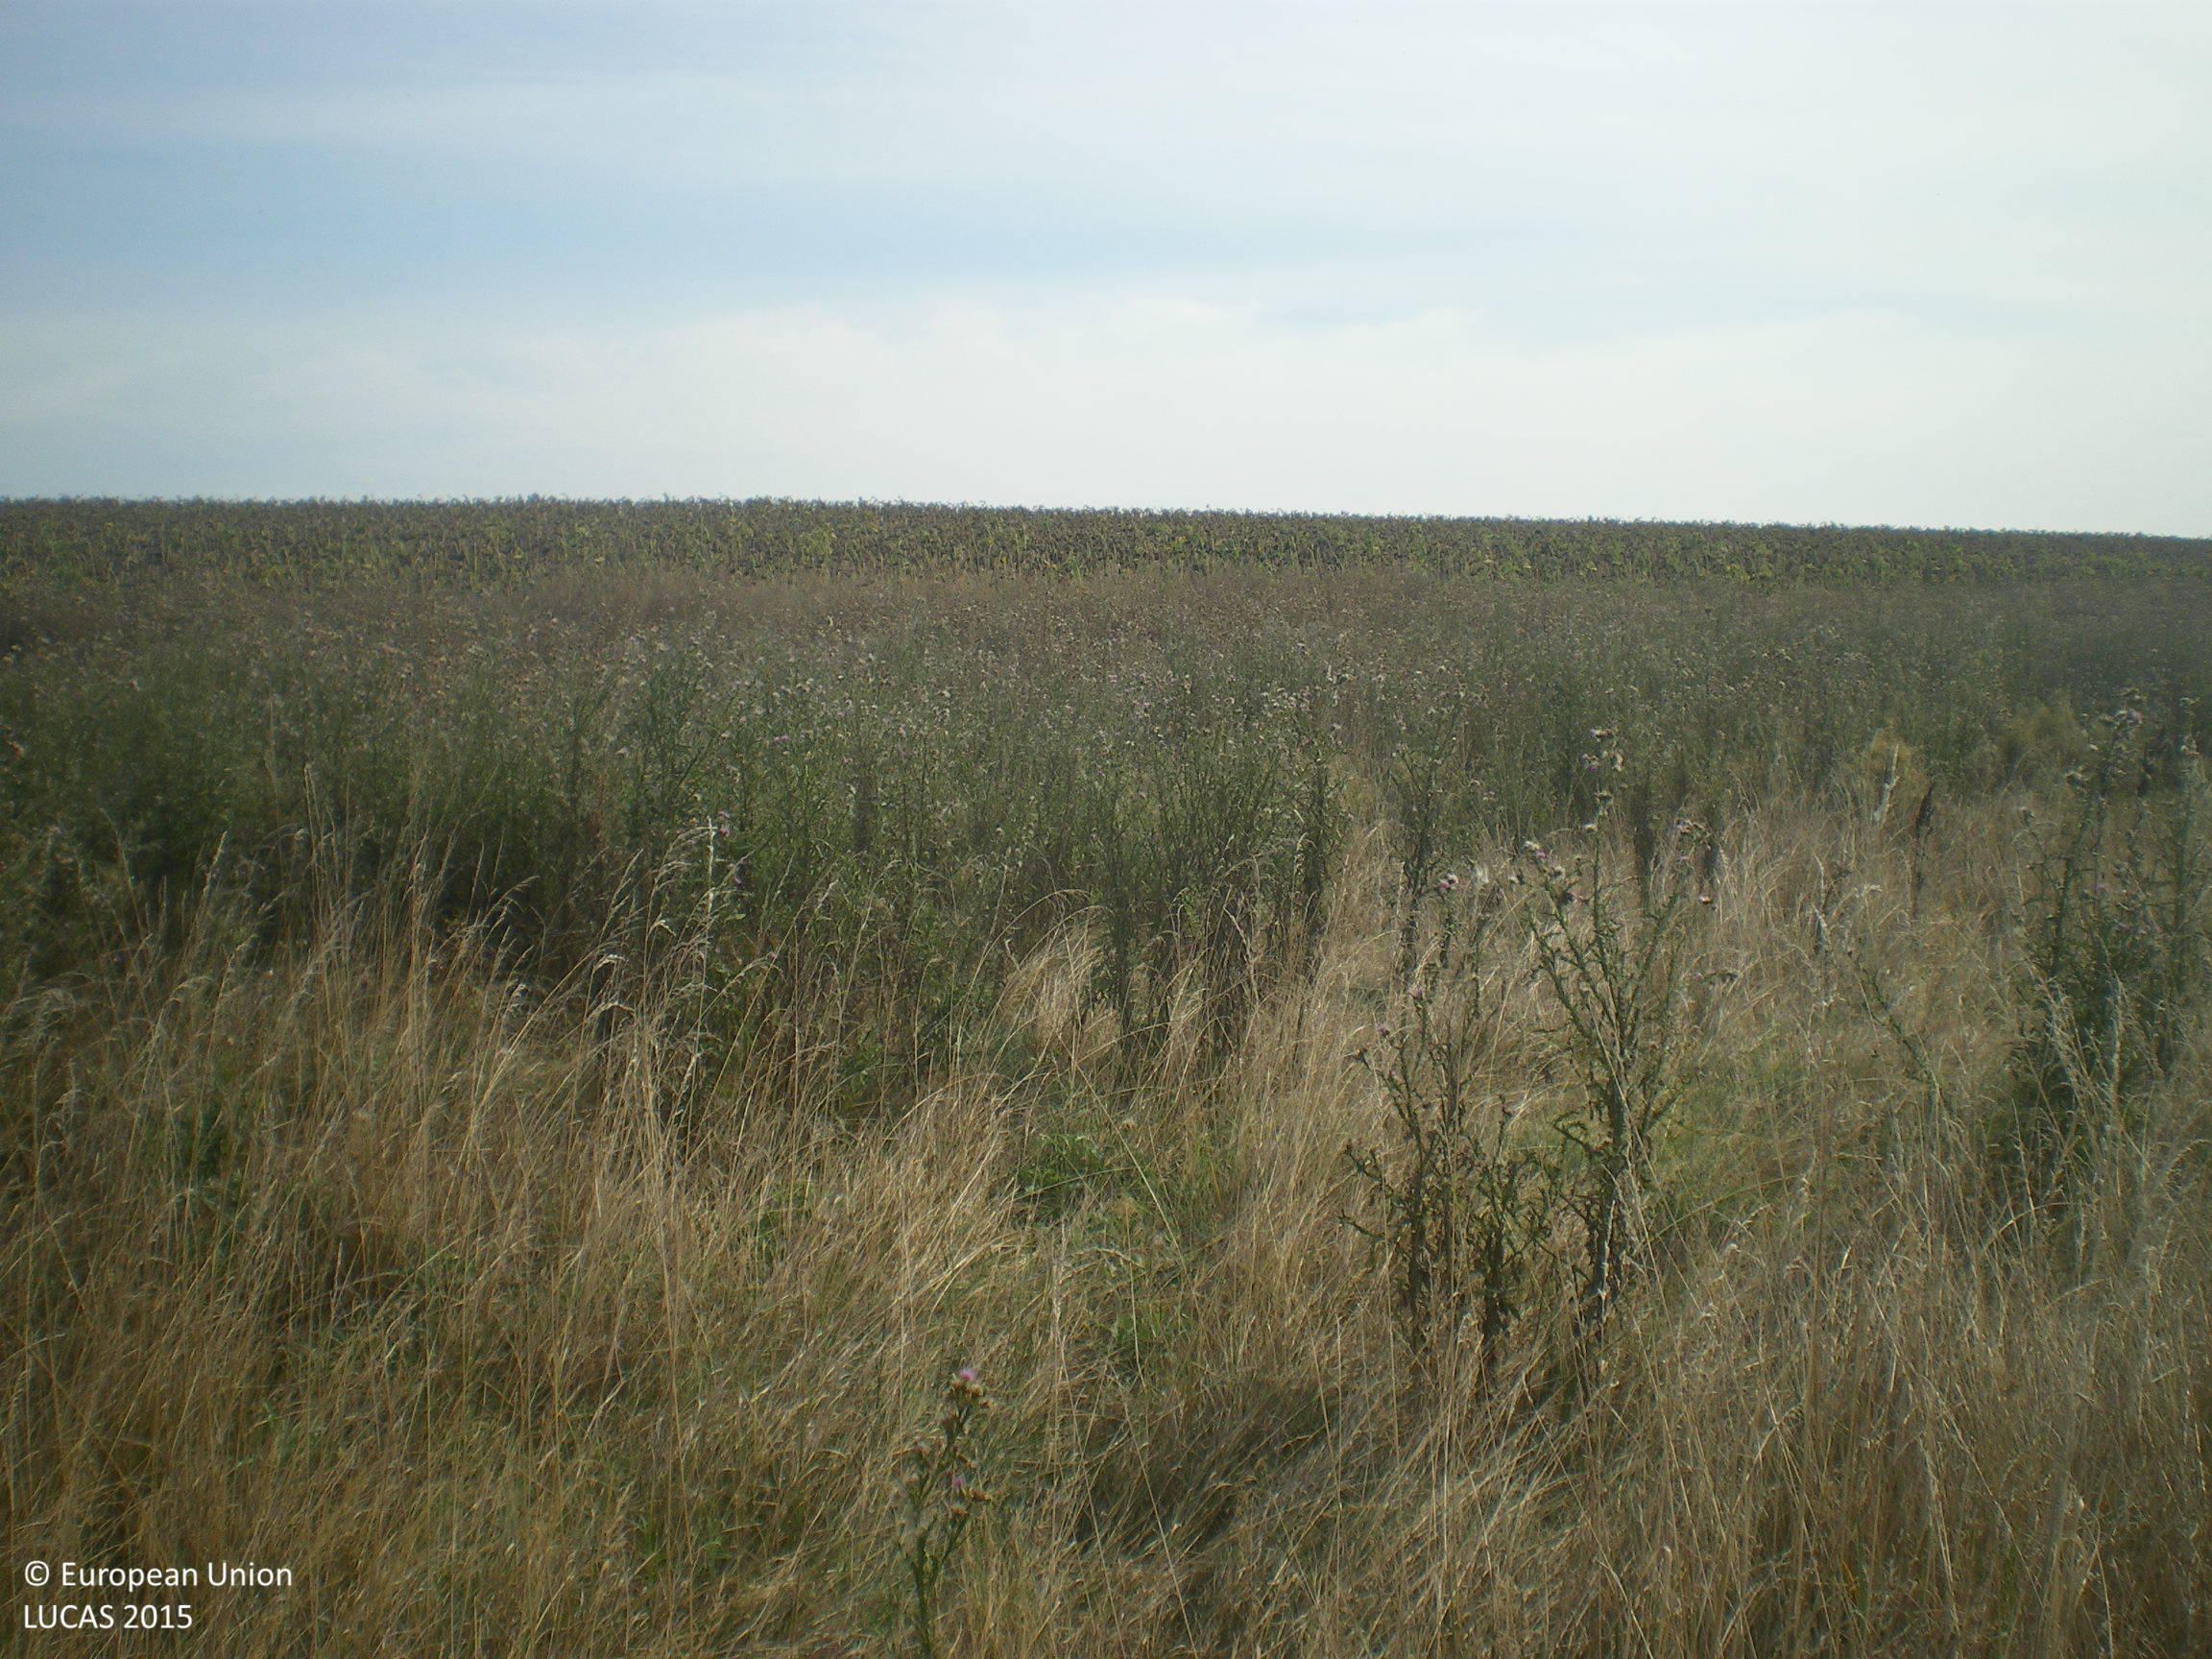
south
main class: Grassland
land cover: Grassland without tree/shrub cover
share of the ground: > 75 %
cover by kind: herbaceous plants 100 %
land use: Agriculture (excluding fallow land and kitchen gardens)
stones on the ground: < 10 %
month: September
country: BG
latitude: 42.2012
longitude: 26.1022
